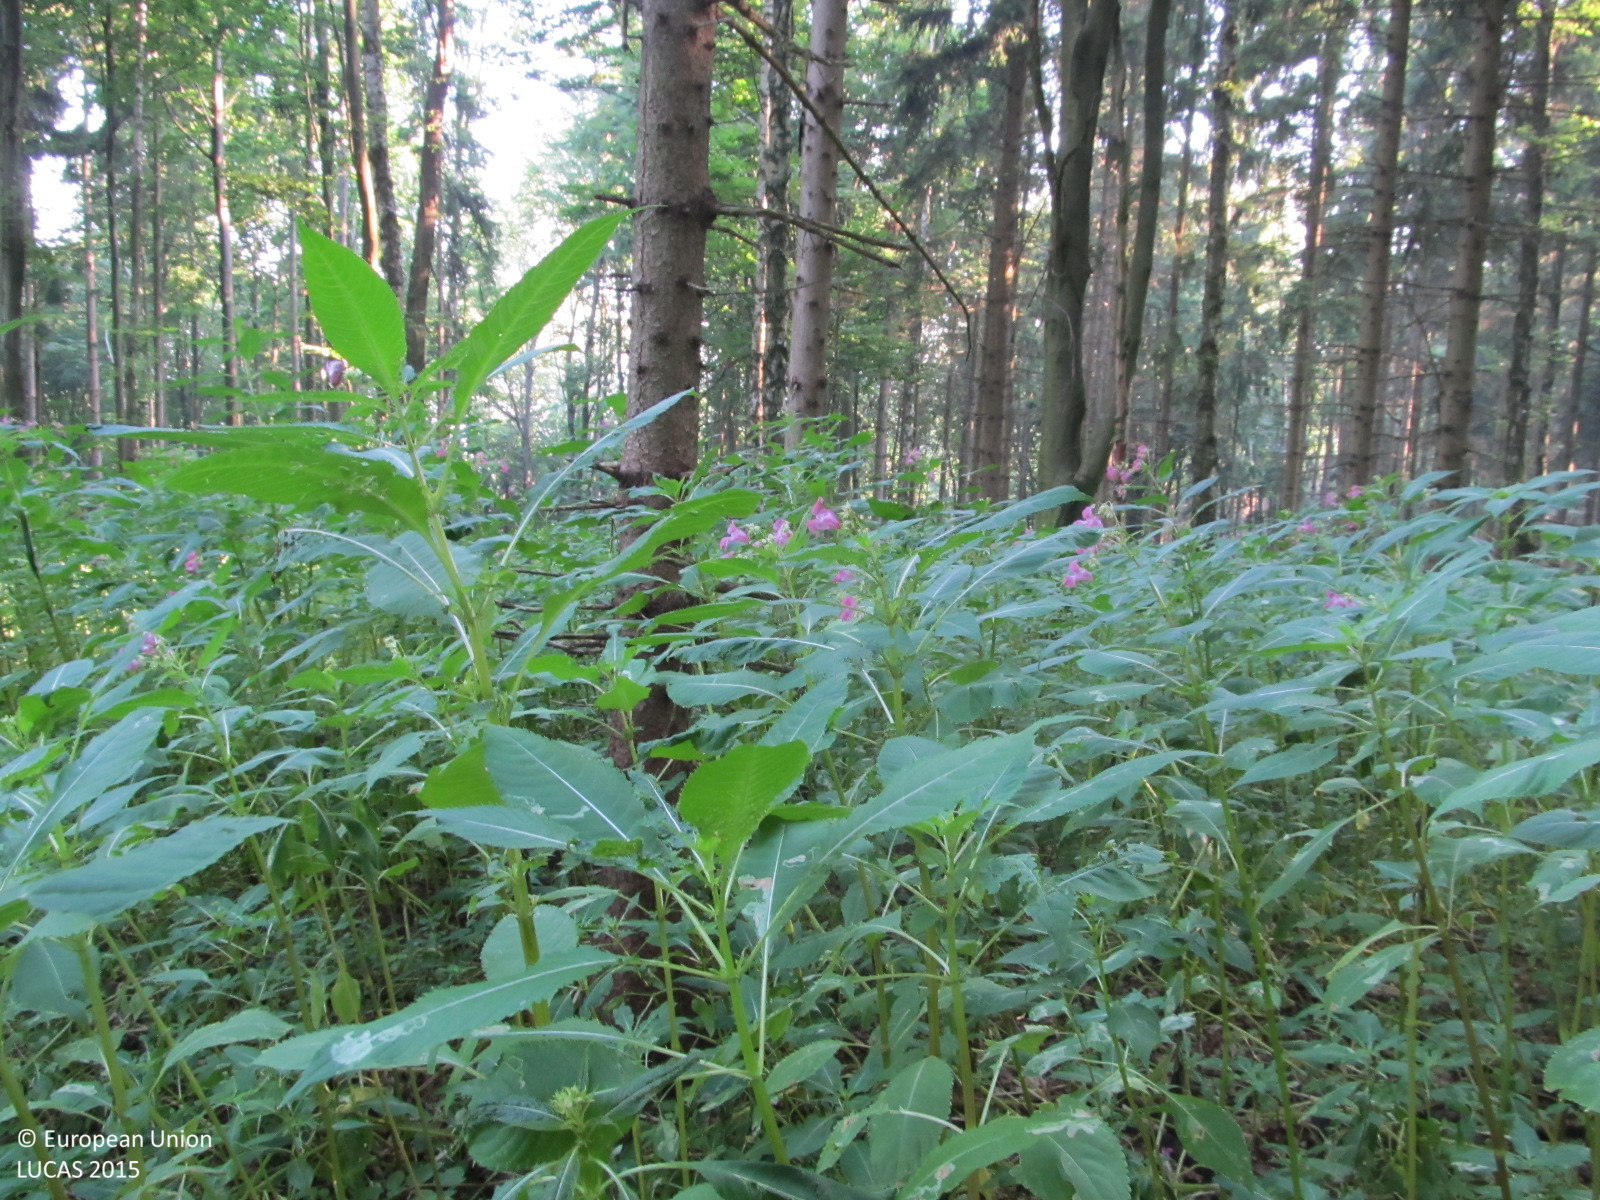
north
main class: Woodland
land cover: Spruce dominated mixed woodland
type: hemiboreal forest and nemoral coniferous forest and mixed broadleaved-coniferous forest
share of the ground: 50 - 75 %
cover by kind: coniferous forest trees 35 %, broadleaved forest trees 35 %, herbaceous plants 20 %, shrubs 10 %
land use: Forestry
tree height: > 5 m
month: August
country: AT
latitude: 48.2315
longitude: 15.8327
